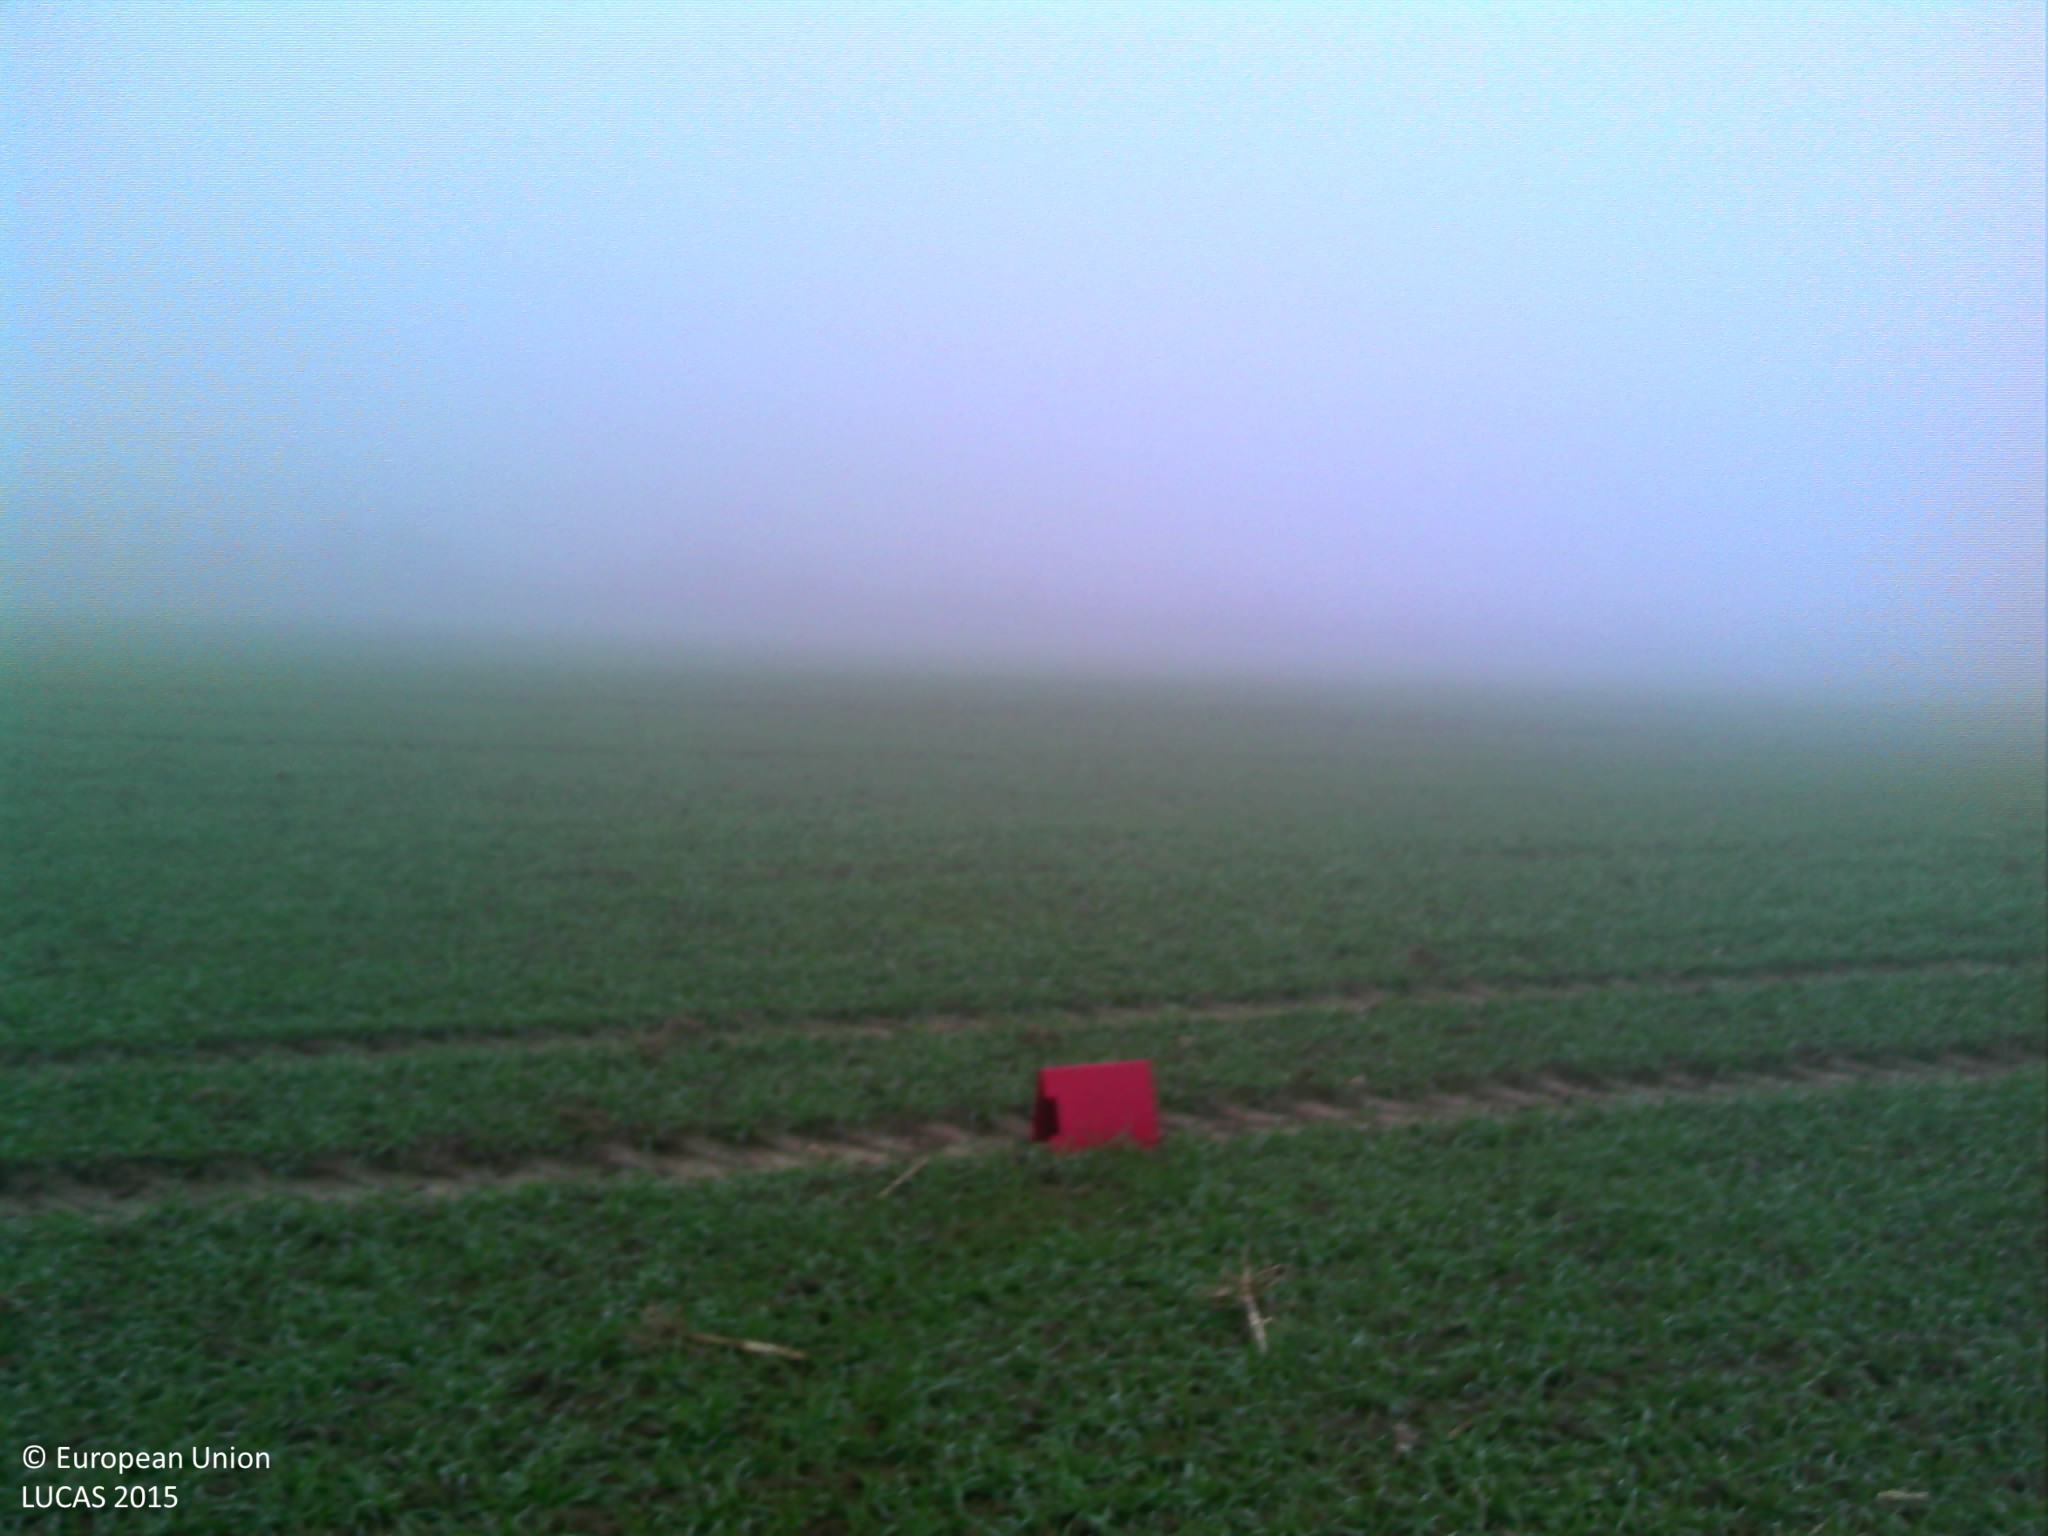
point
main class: Cropland
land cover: Common wheat
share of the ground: > 75 %
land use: Agriculture (excluding fallow land and kitchen gardens)
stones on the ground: < 10 %
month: December
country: FR
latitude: 46.2396
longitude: 5.1137
